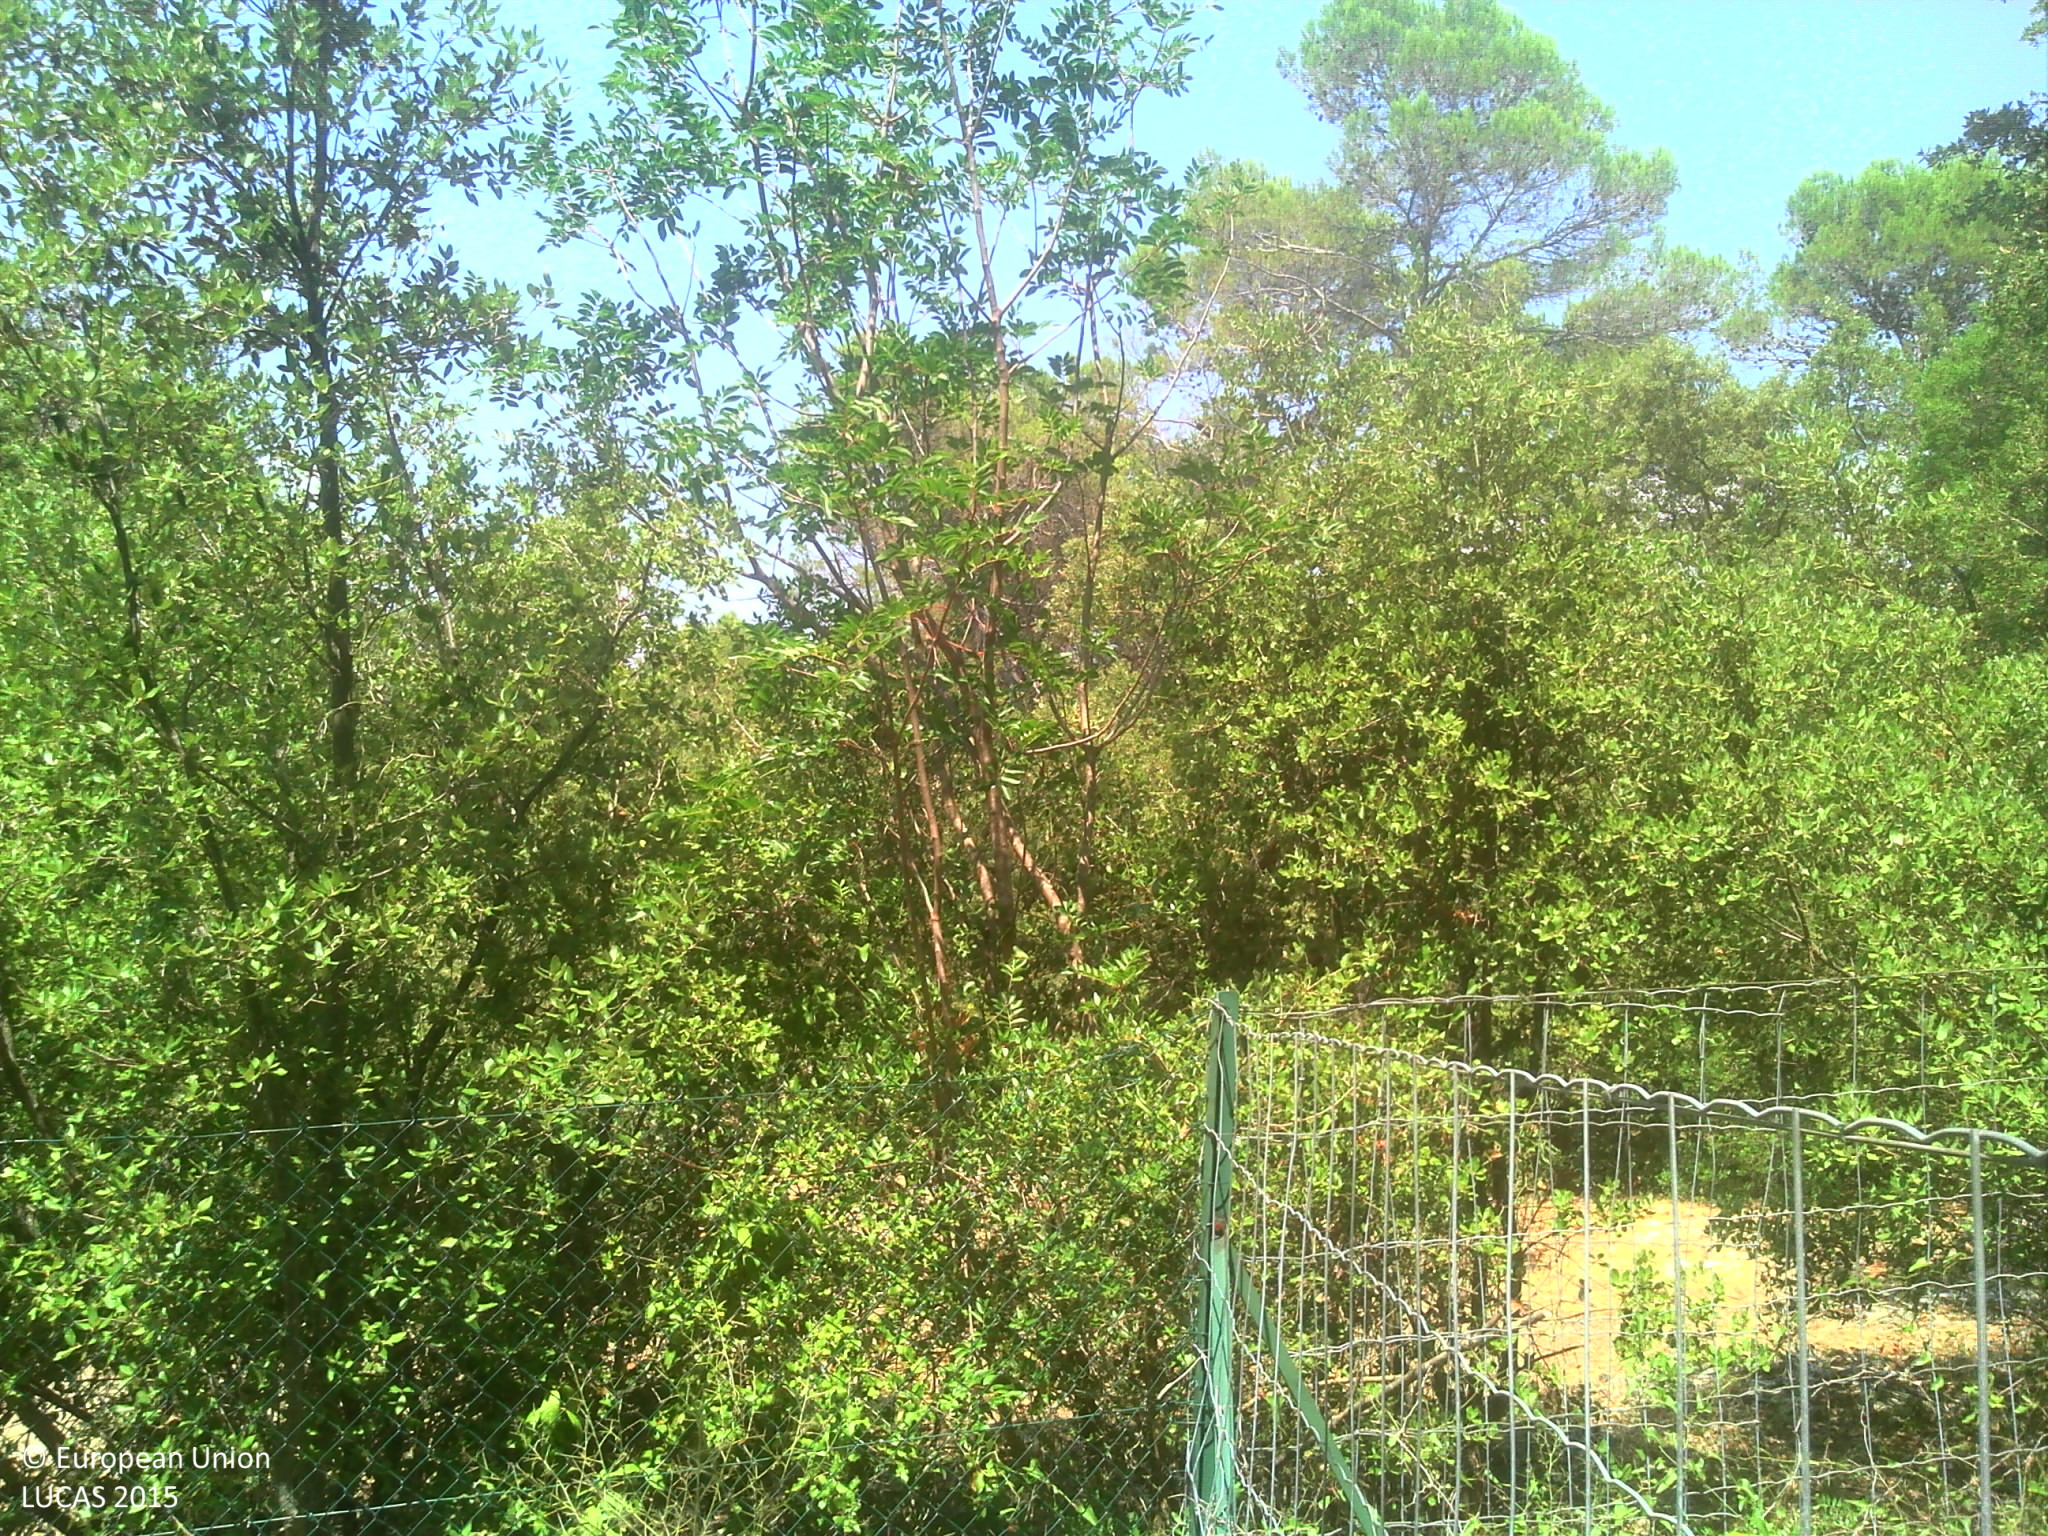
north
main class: Woodland
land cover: Pine dominated mixed woodland
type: broadleaved evergreen forest
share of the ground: > 75 %
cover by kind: broadleaved forest trees 40 %, coniferous forest trees 35 %, herbaceous plants 25 %
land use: Residential
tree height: > 5 m
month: July
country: FR
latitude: 43.4579
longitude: 6.4123
